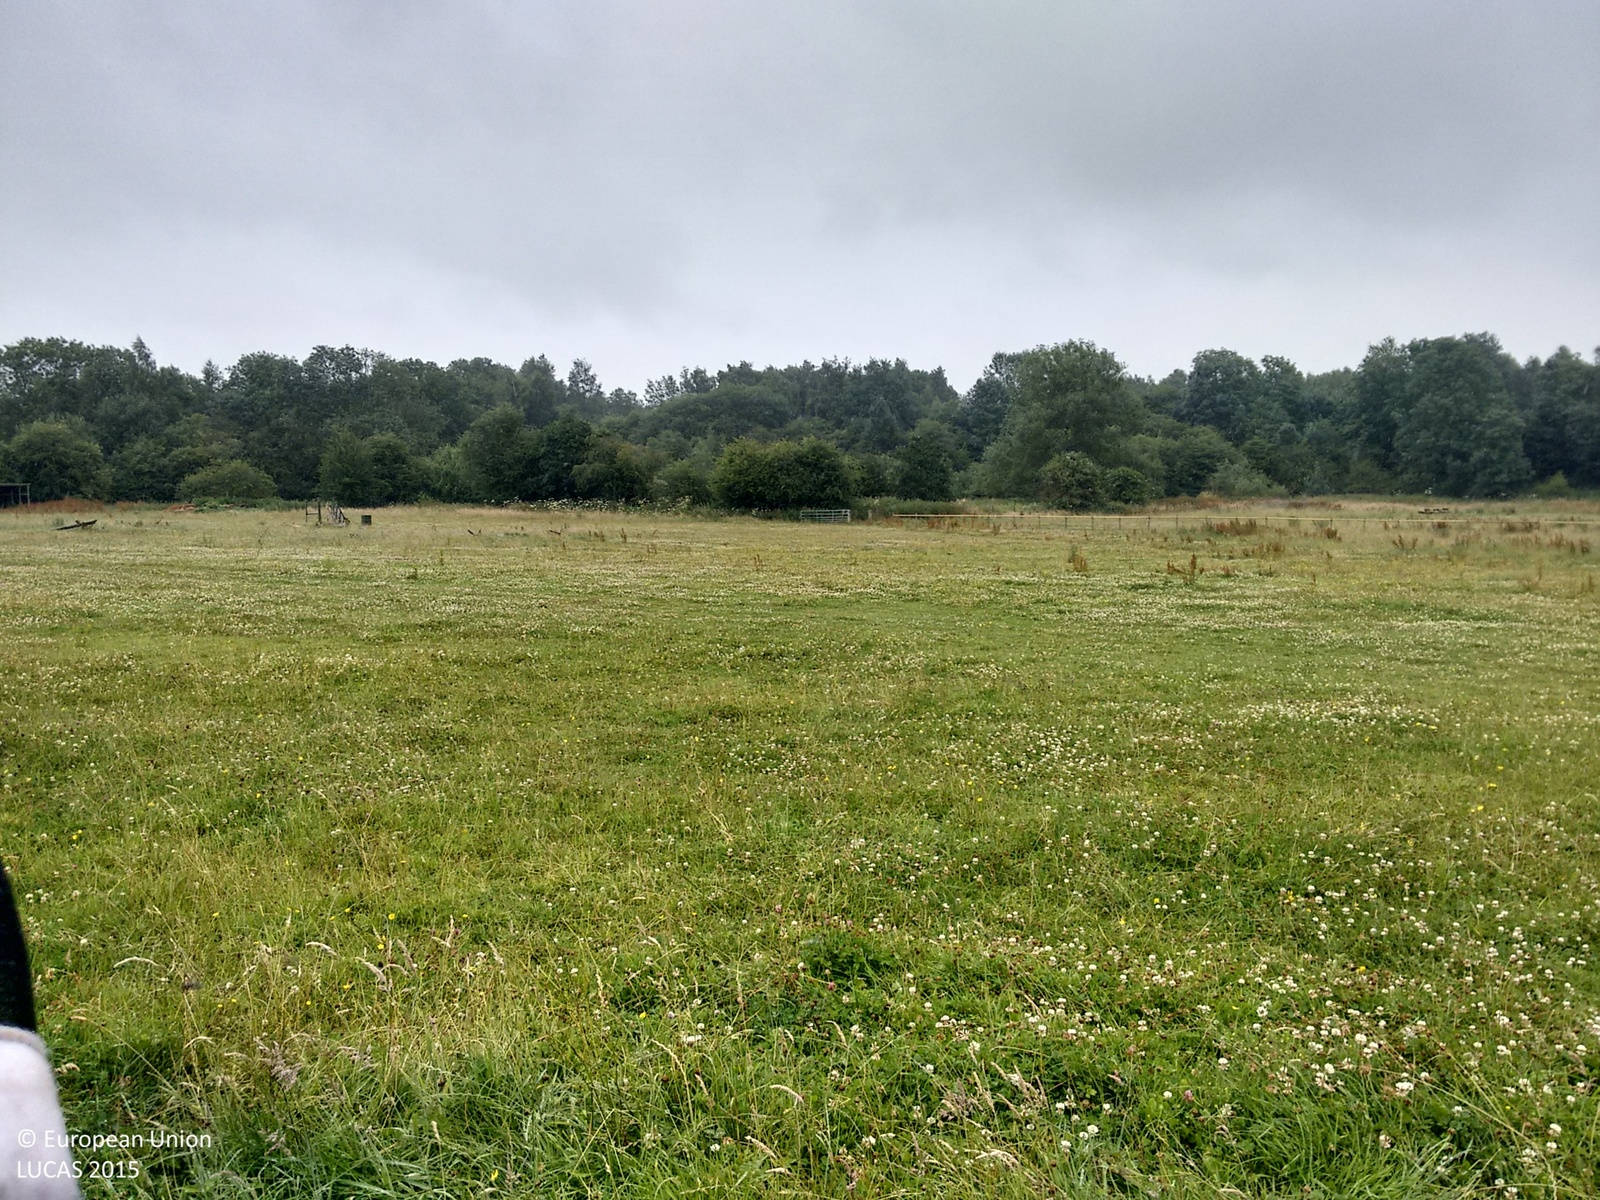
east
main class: Grassland
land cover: Grassland without tree/shrub cover
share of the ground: > 75 %
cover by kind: herbaceous plants 100 %
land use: Agriculture (excluding fallow land and kitchen gardens)
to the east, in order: Grassland without tree/shrub cover; Fences; Grass margins; Abandoned hedges; Rivers and streams; Abandoned hedges; Grassland without tree/shrub cover; Broadleaved woodland; Fences; Grass margins; Railways; Grass margins; Fences; Broadleaved woodland; Ditches and canals; Abandoned hedges
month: July
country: GB
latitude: 53.0665
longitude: -1.3455
